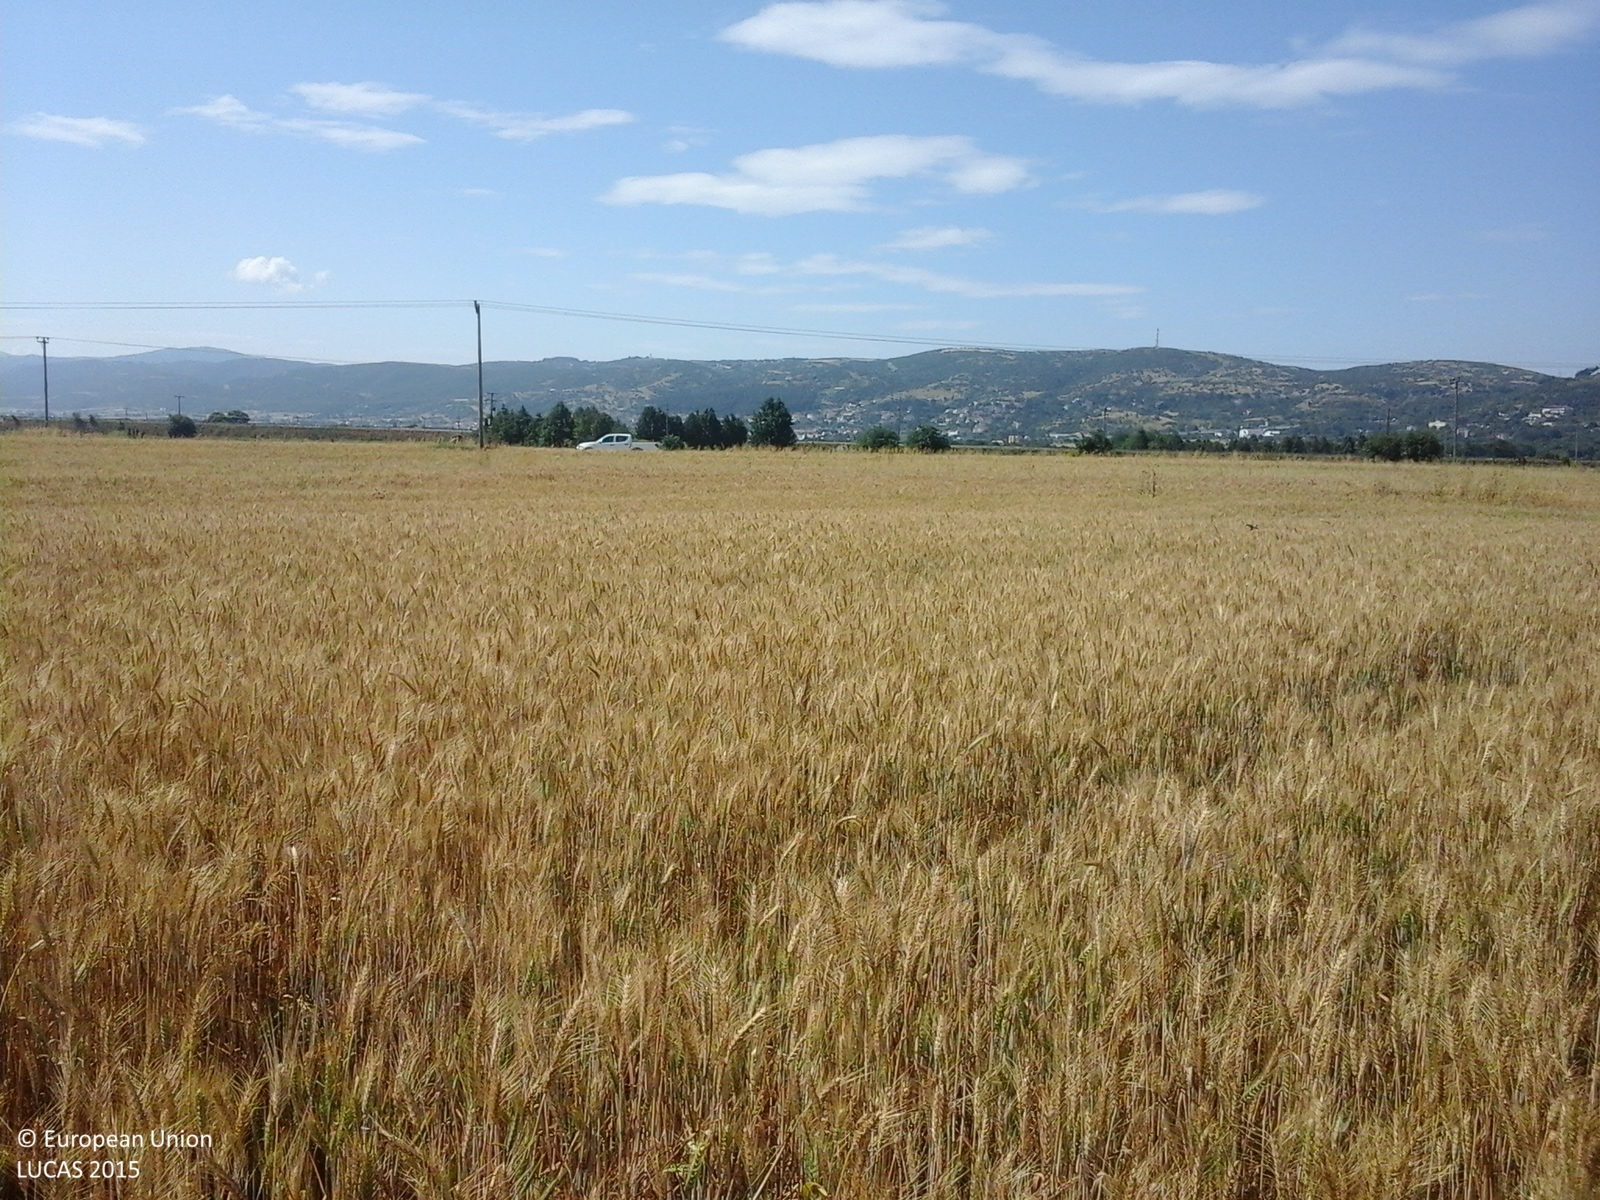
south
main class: Cropland
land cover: Common wheat
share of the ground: > 75 %
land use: Agriculture (excluding fallow land and kitchen gardens)
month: June
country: GR
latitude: 40.7519
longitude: 23.0023
